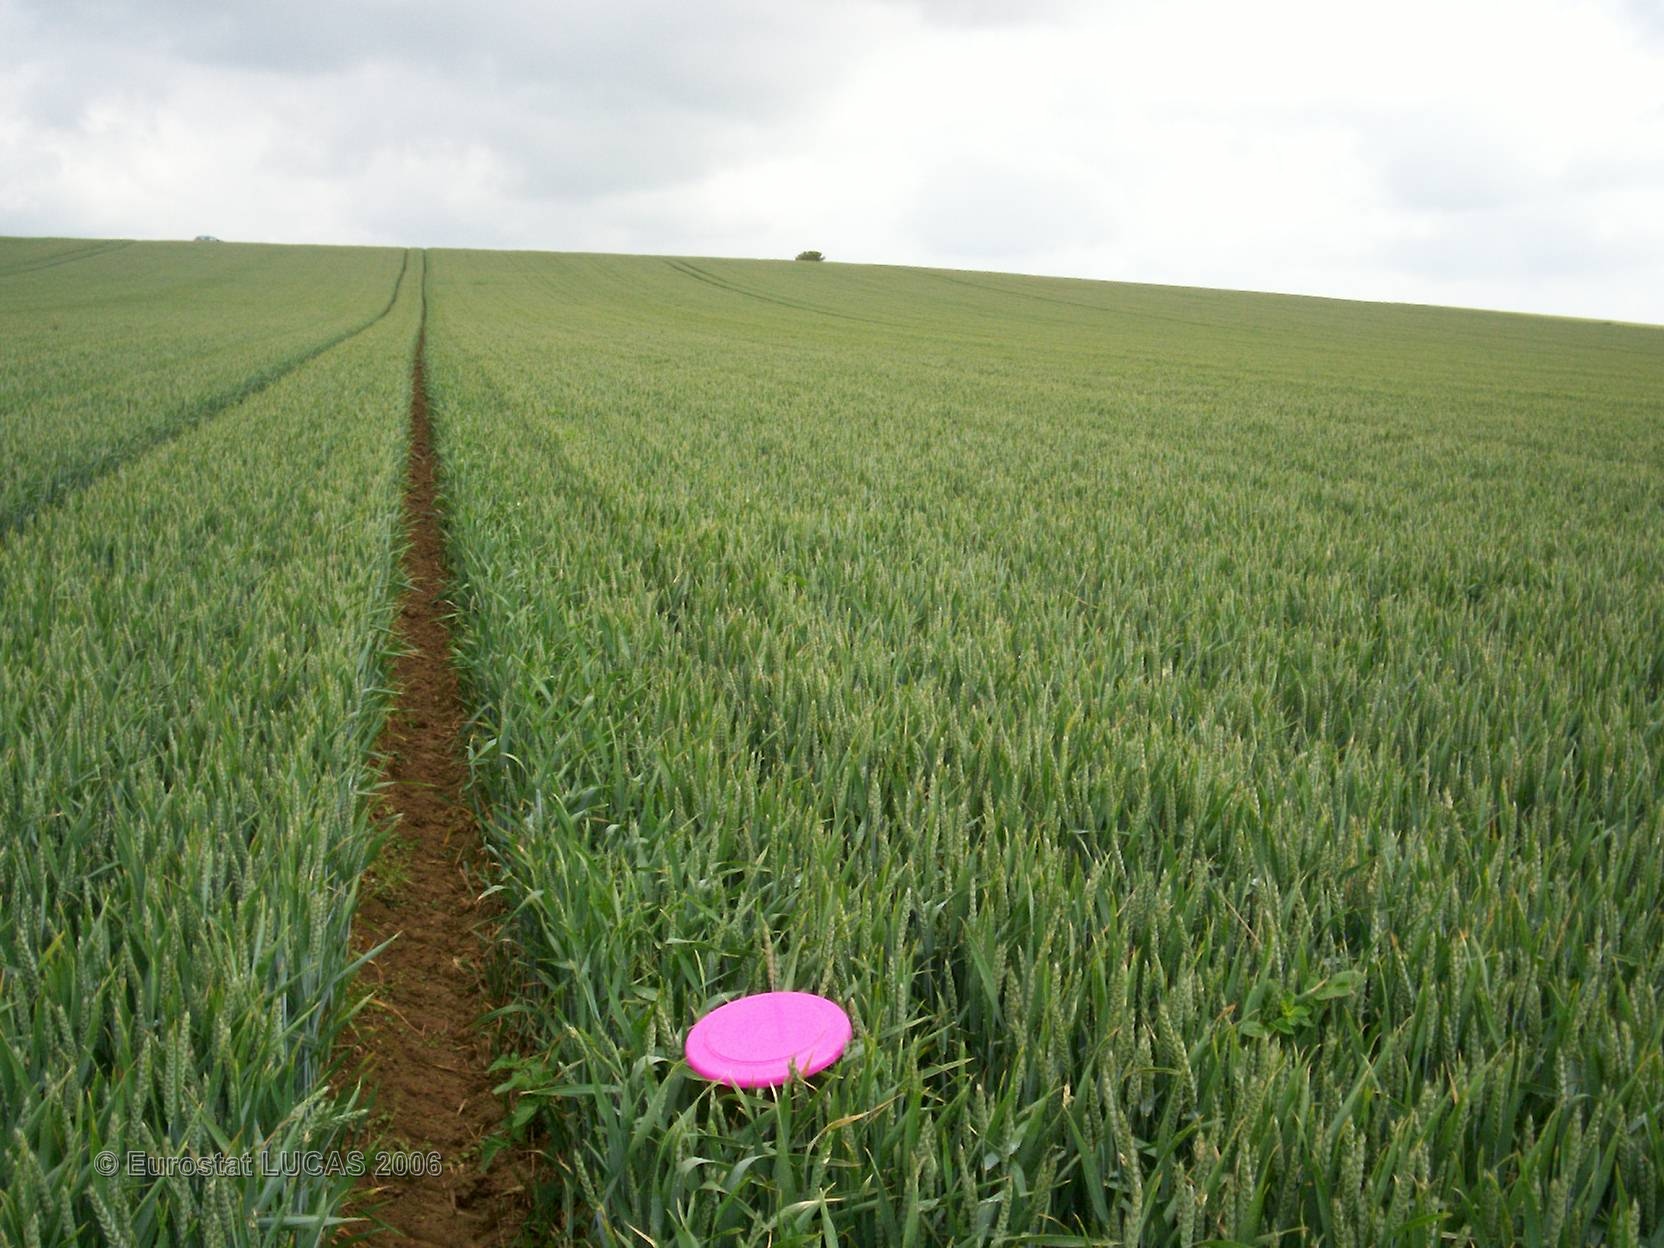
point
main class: Cropland
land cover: Common wheat
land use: Agriculture (excluding fallow land and kitchen gardens)
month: June
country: FR
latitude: 48.5723
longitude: 4.4810
